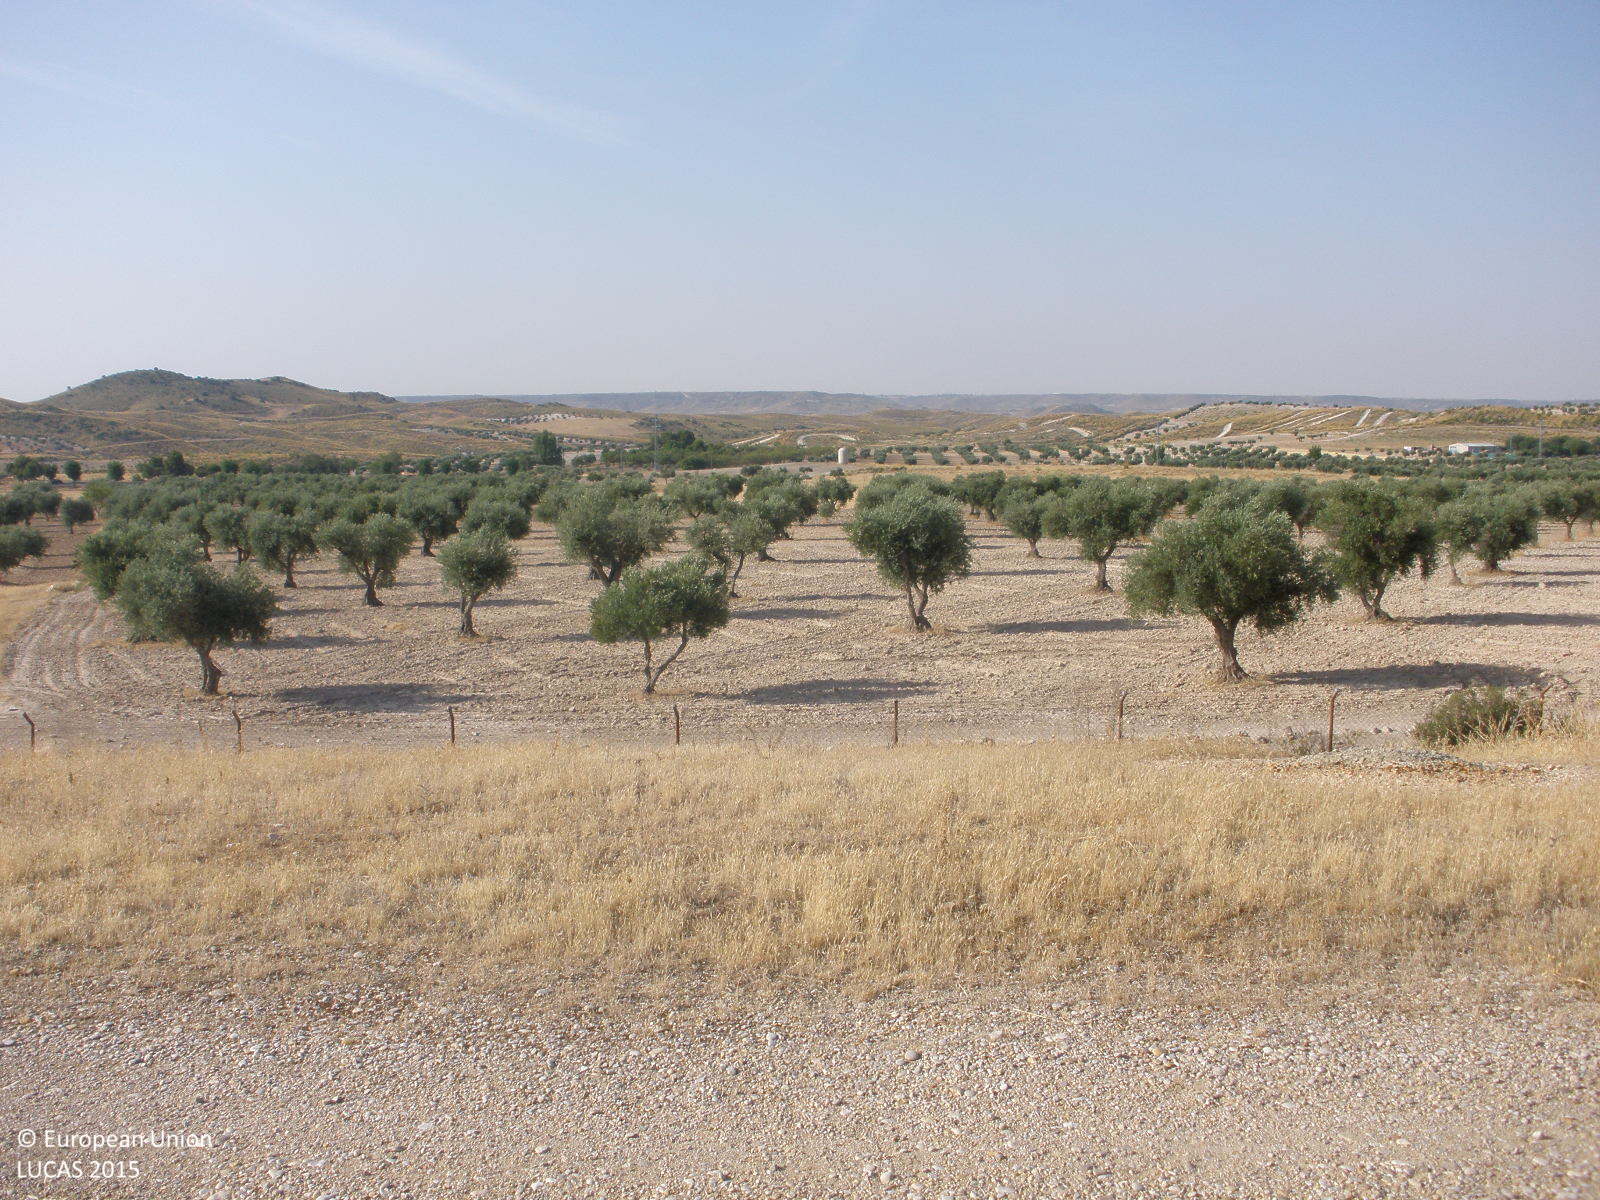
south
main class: Grassland
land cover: Grassland without tree/shrub cover
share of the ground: 50 - 75 %
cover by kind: herbaceous plants 70 %, consolidated bare surface 30 %
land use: Waste treatment
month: July
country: ES
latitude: 40.0894
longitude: -3.4356
